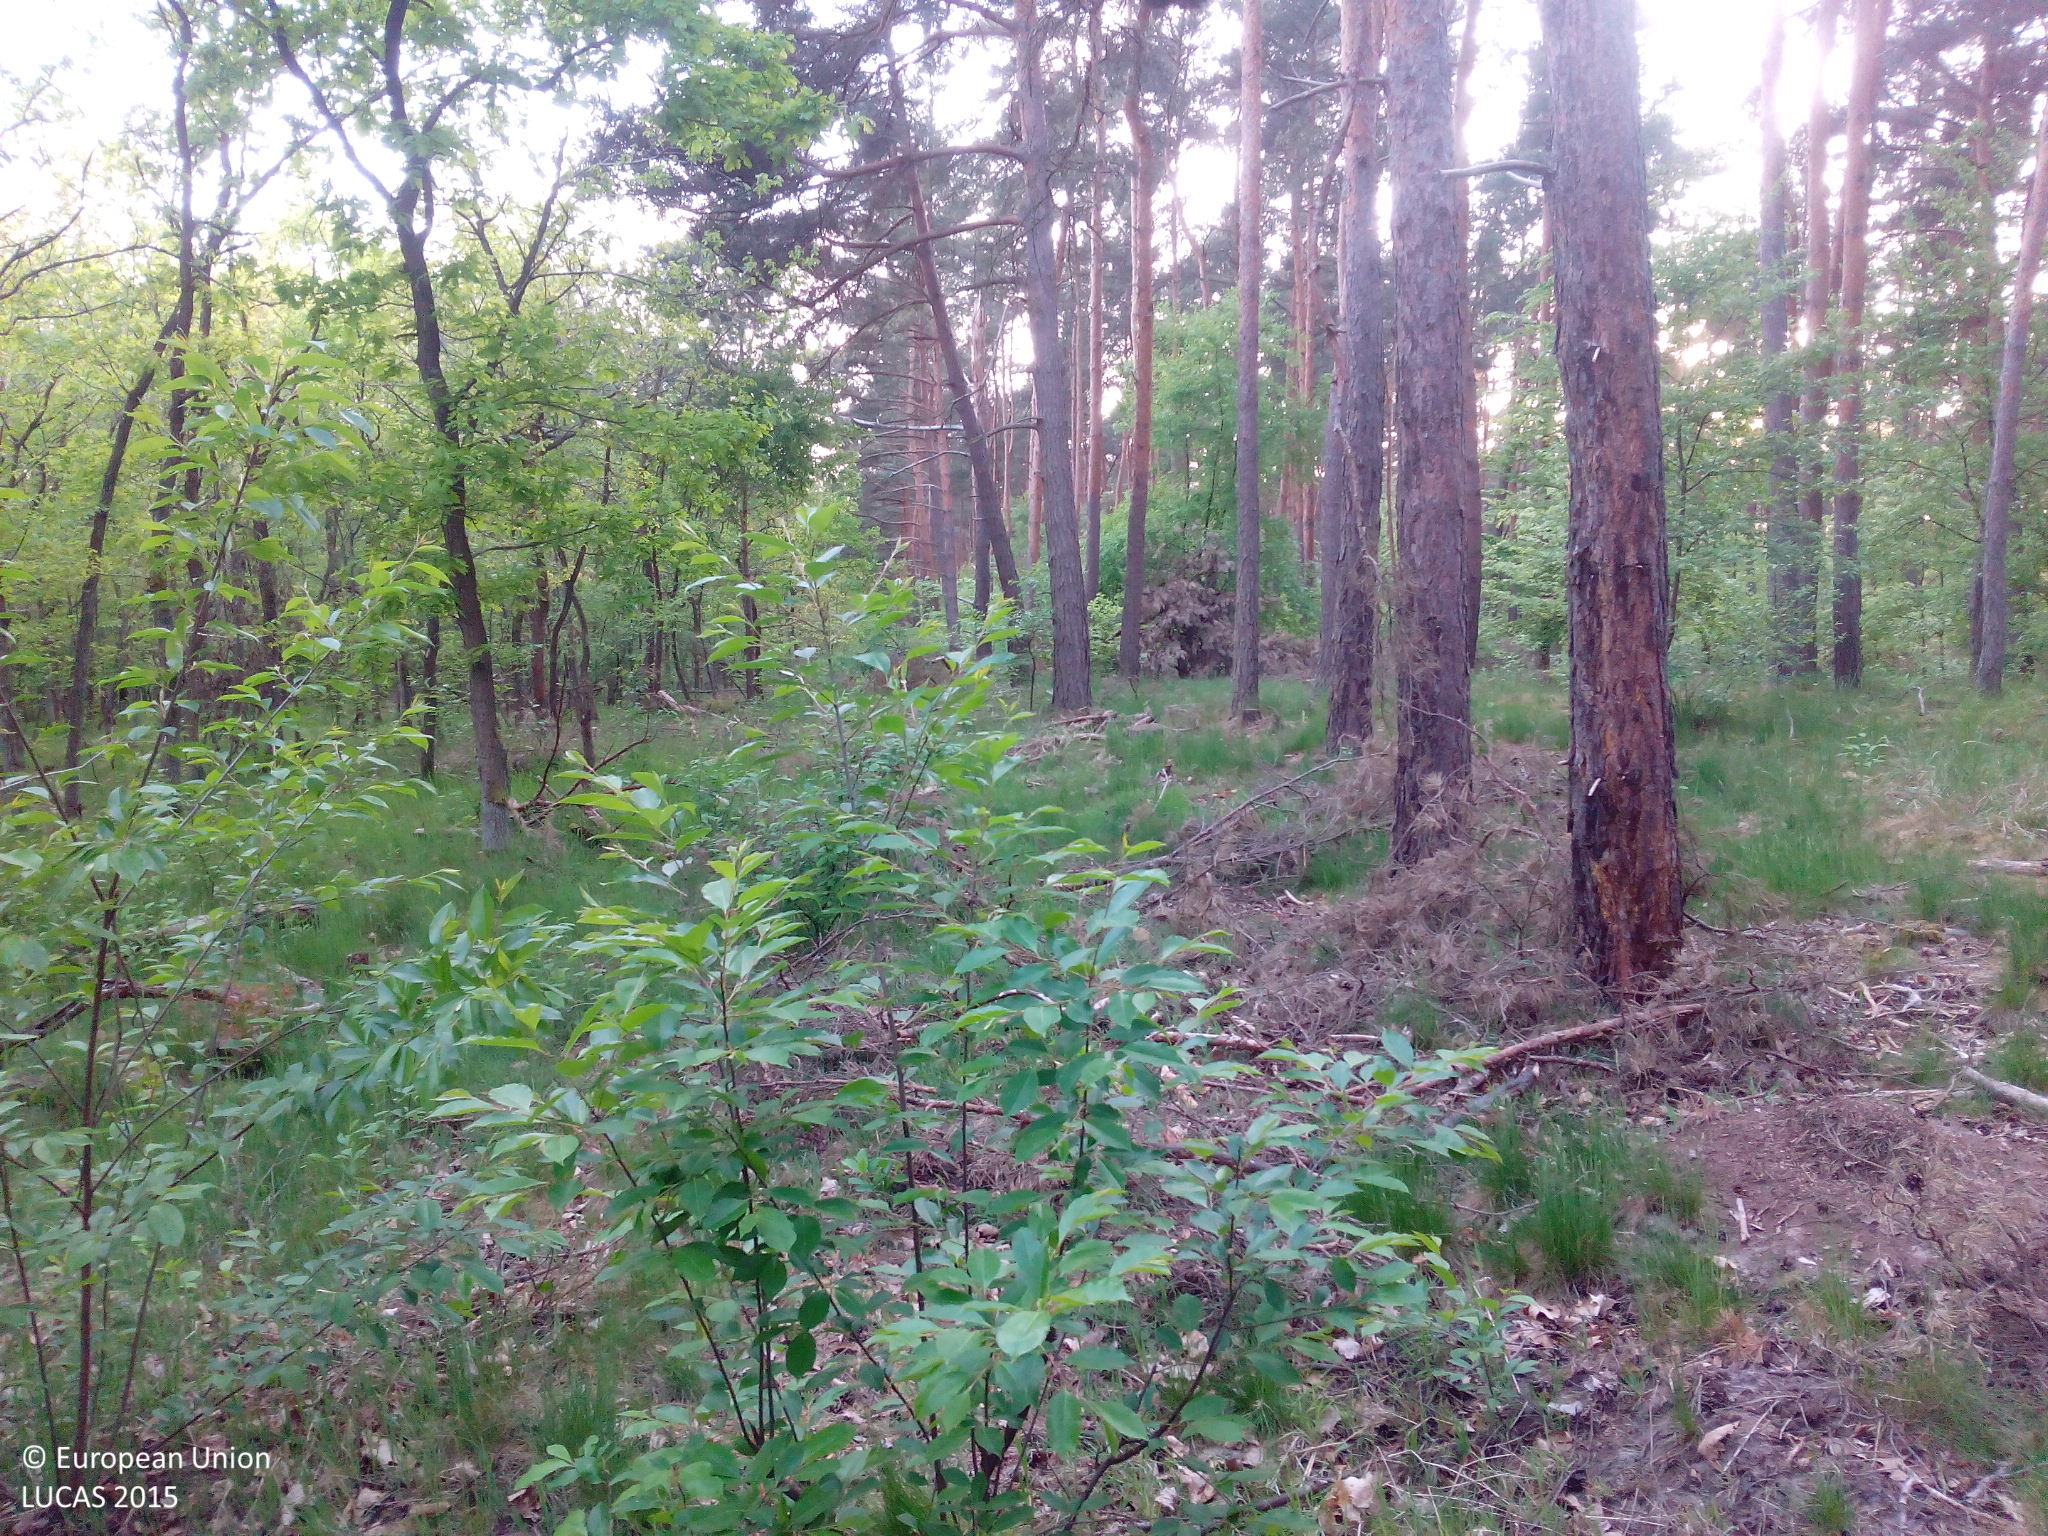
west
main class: Woodland
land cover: Pine dominated coniferous woodland
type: hemiboreal forest and nemoral coniferous forest and mixed broadleaved-coniferous forest
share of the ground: > 75 %
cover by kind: coniferous forest trees 60 %, herbaceous plants 20 %, broadleaved forest trees 15 %, unconsolidated bare surface 5 %
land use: Forestry
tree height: > 5 m
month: May
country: DE
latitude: 49.5994
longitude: 8.5477
